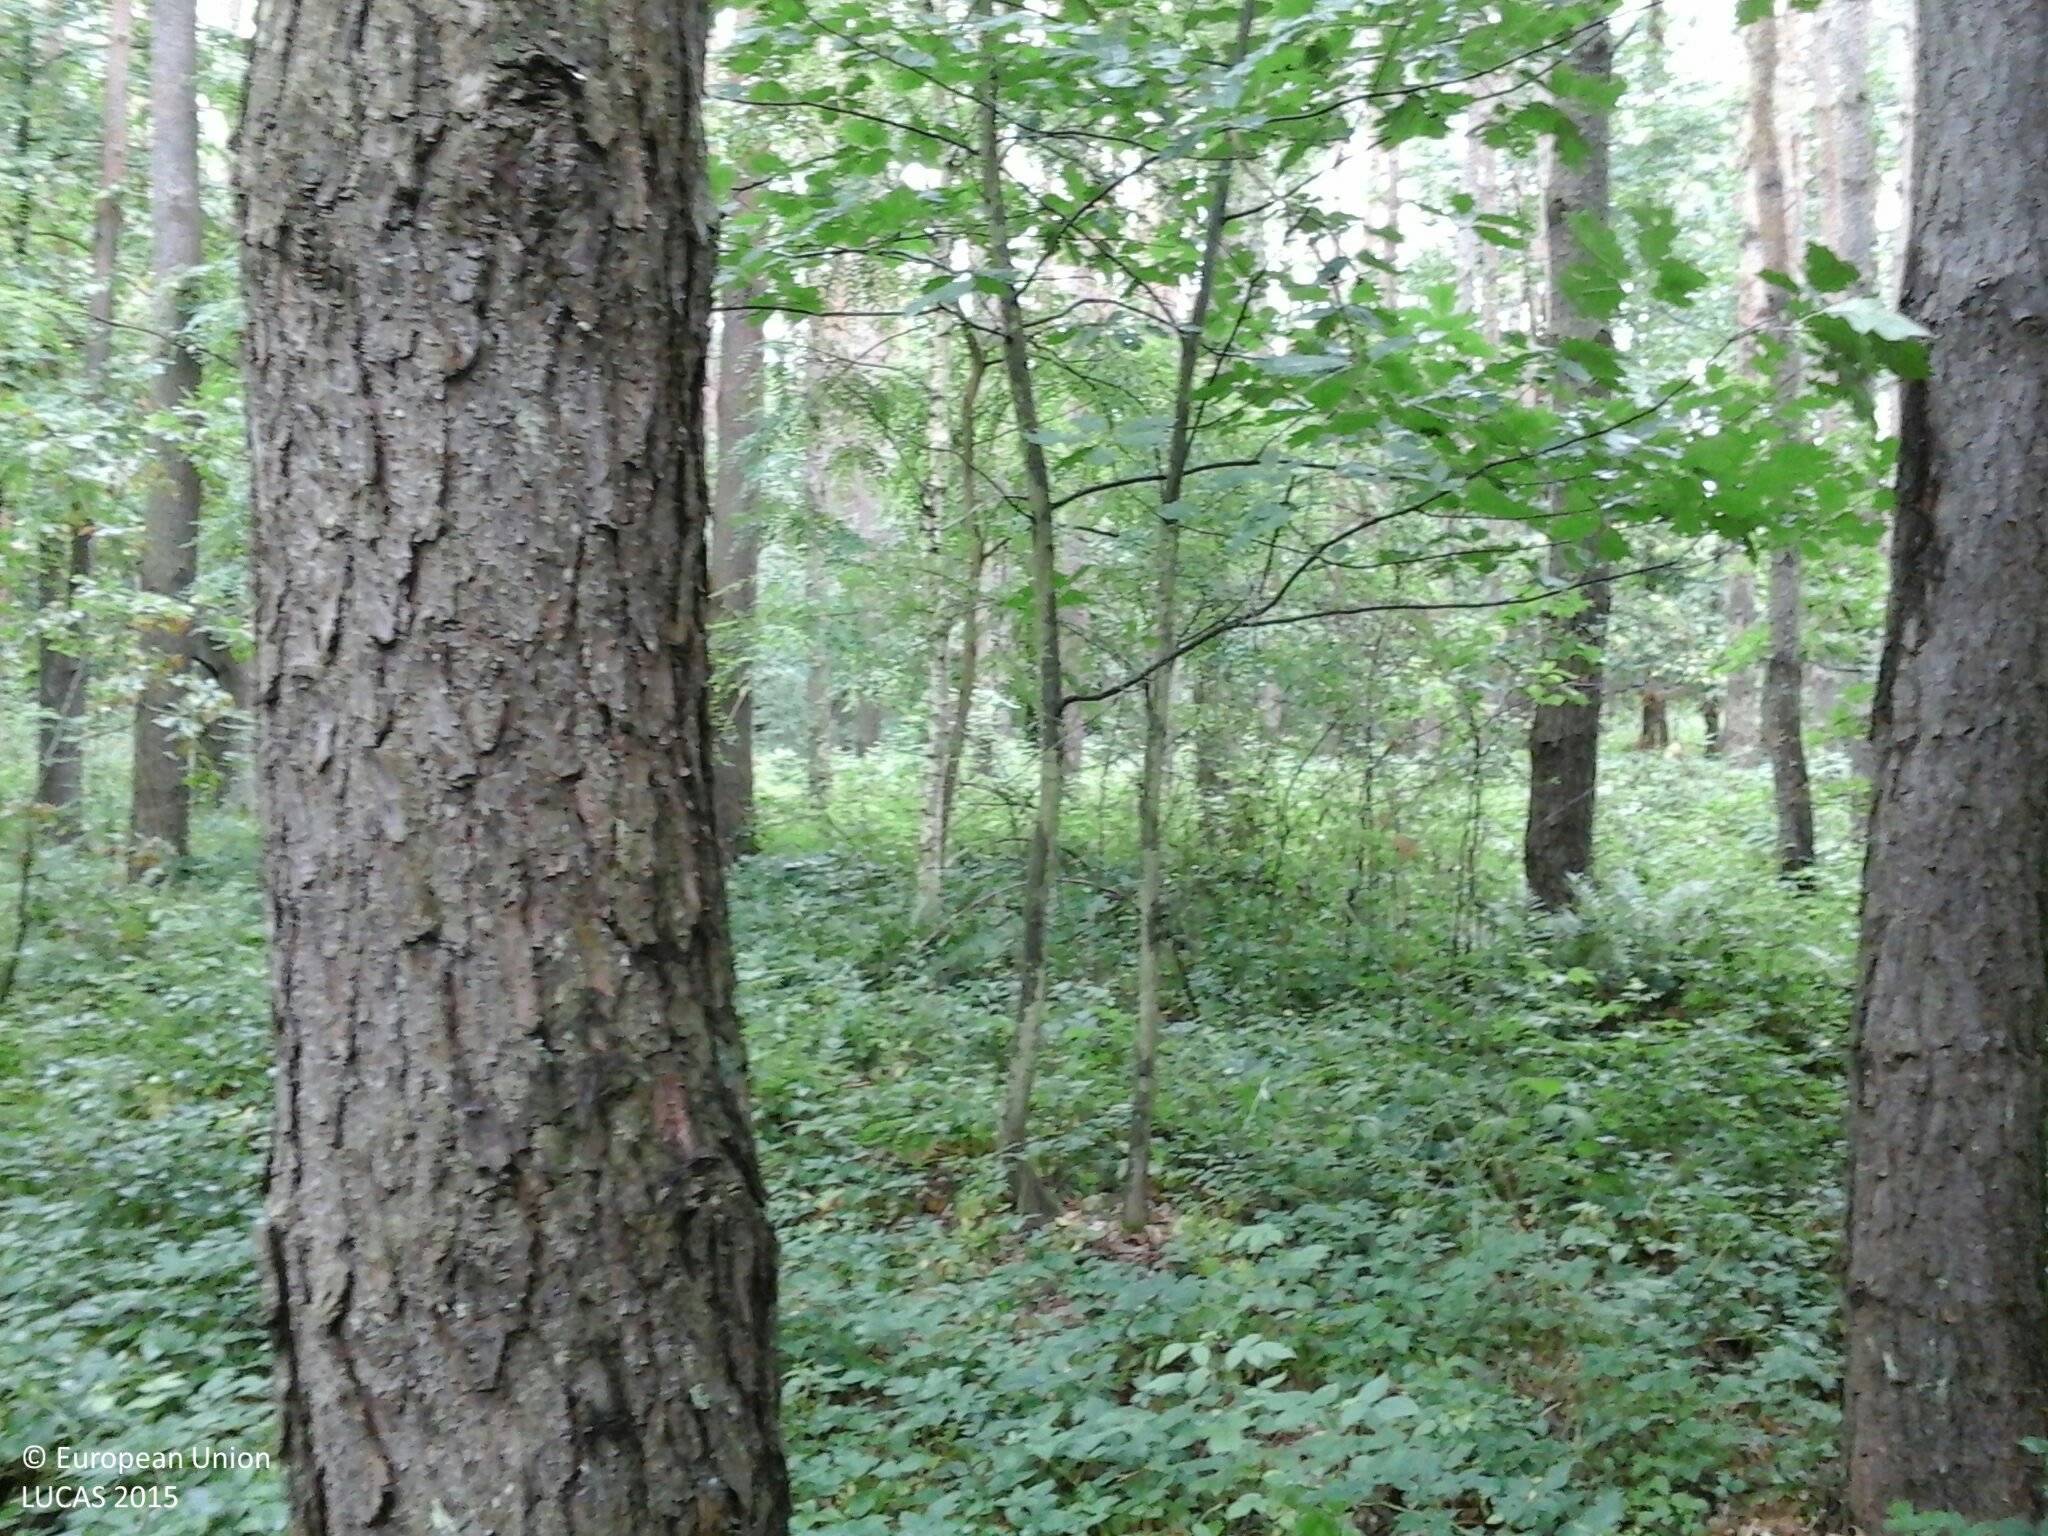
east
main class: Woodland
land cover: Pine dominated mixed woodland
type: hemiboreal forest and nemoral coniferous forest and mixed broadleaved-coniferous forest
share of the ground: > 75 %
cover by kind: coniferous forest trees 40 %, broadleaved forest trees 30 %, shrubs 20 %, herbaceous plants 10 %
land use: Forestry
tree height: > 5 m
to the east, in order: Pine dominated mixed woodland; Pine dominated coniferous woodland; Ditches and canals; Grass margins; Tracks; Grass margins; Ditches and canals; Broadleaved woodland
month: July
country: HU
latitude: 46.9089
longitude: 16.5538
